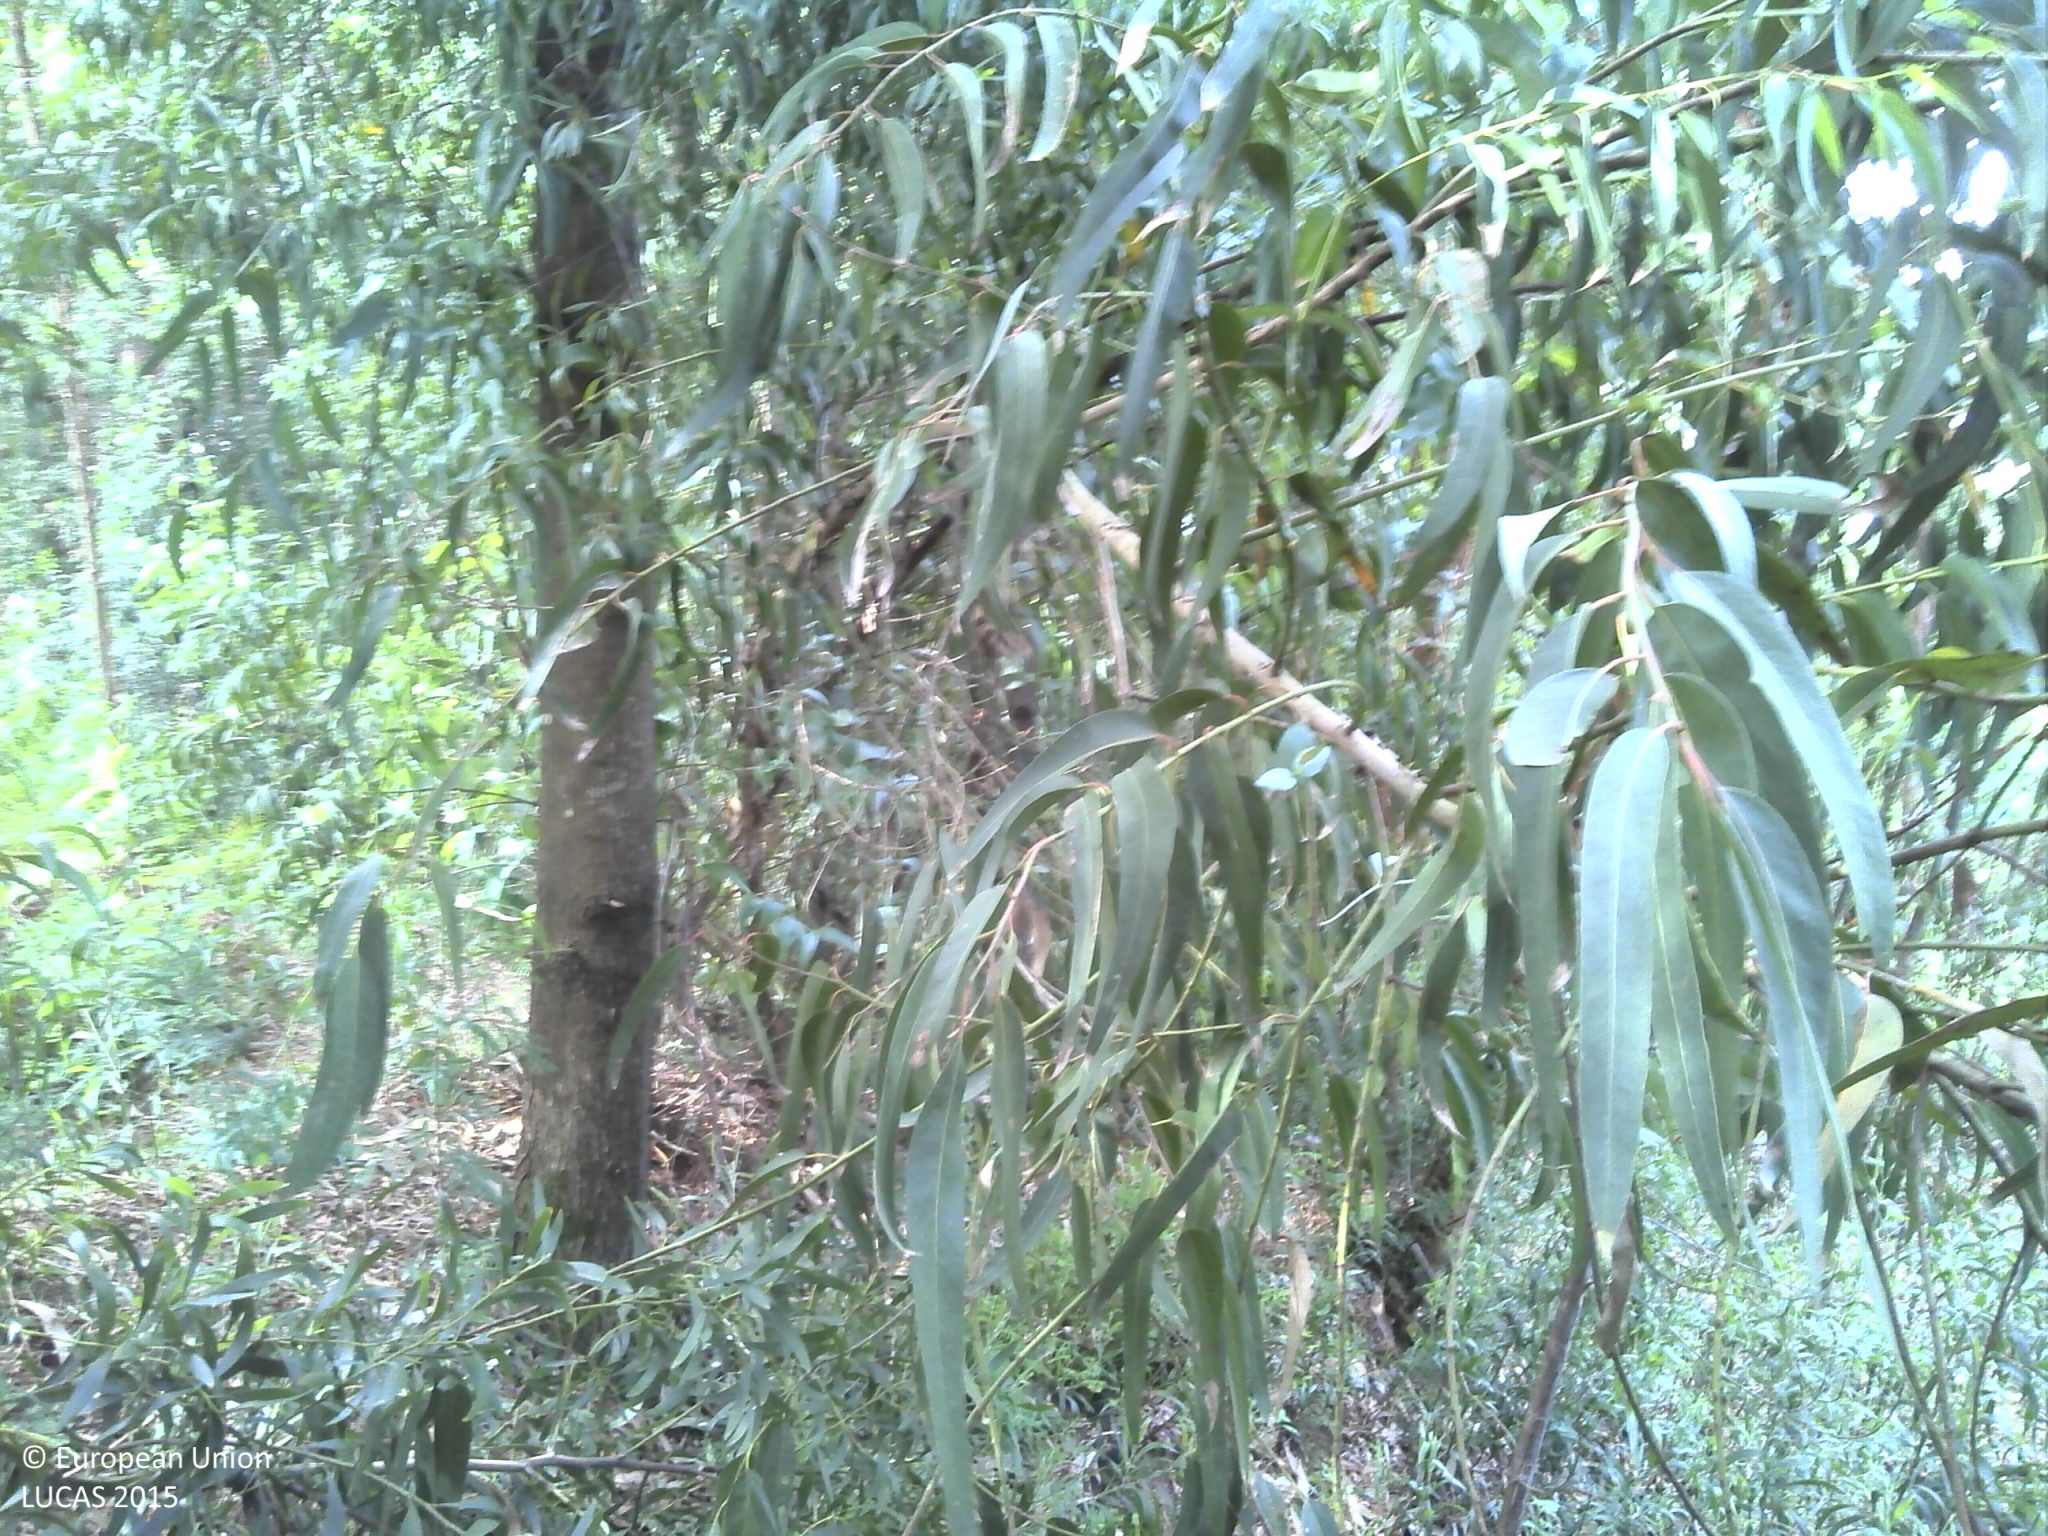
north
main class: Woodland
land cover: Broadleaved woodland
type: exotic forest
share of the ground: > 75 %
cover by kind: broadleaved forest trees 85 %, shrubs 10 %, unconsolidated bare surface 5 %
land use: Forestry
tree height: > 5 m
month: May
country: PT
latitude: 40.9419
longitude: -8.3505
